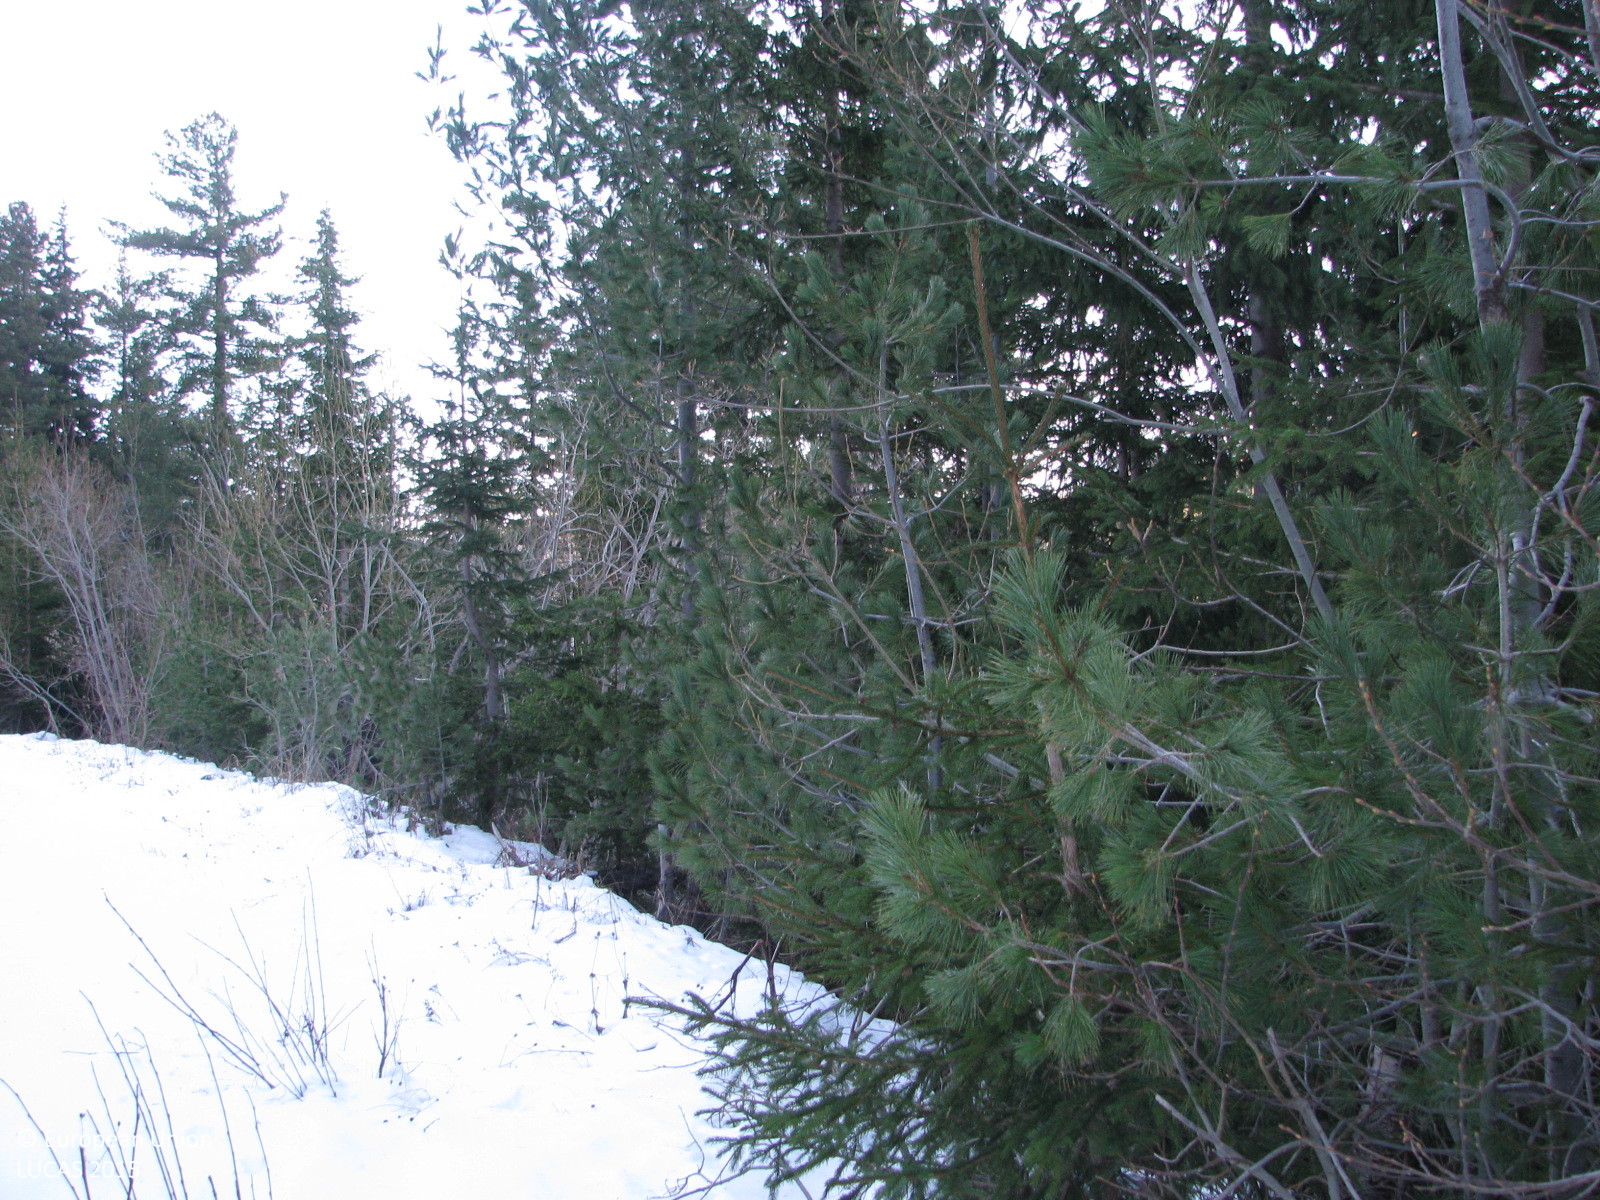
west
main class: Woodland
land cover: Spruce dominated mixed woodland
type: hemiboreal forest and nemoral coniferous forest and mixed broadleaved-coniferous forest
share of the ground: > 75 %
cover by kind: coniferous forest trees 60 %, broadleaved forest trees 25 %, unconsolidated bare surface 15 %
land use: Forestry
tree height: < 5 m
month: December
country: BG
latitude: 42.1942
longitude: 23.8296
